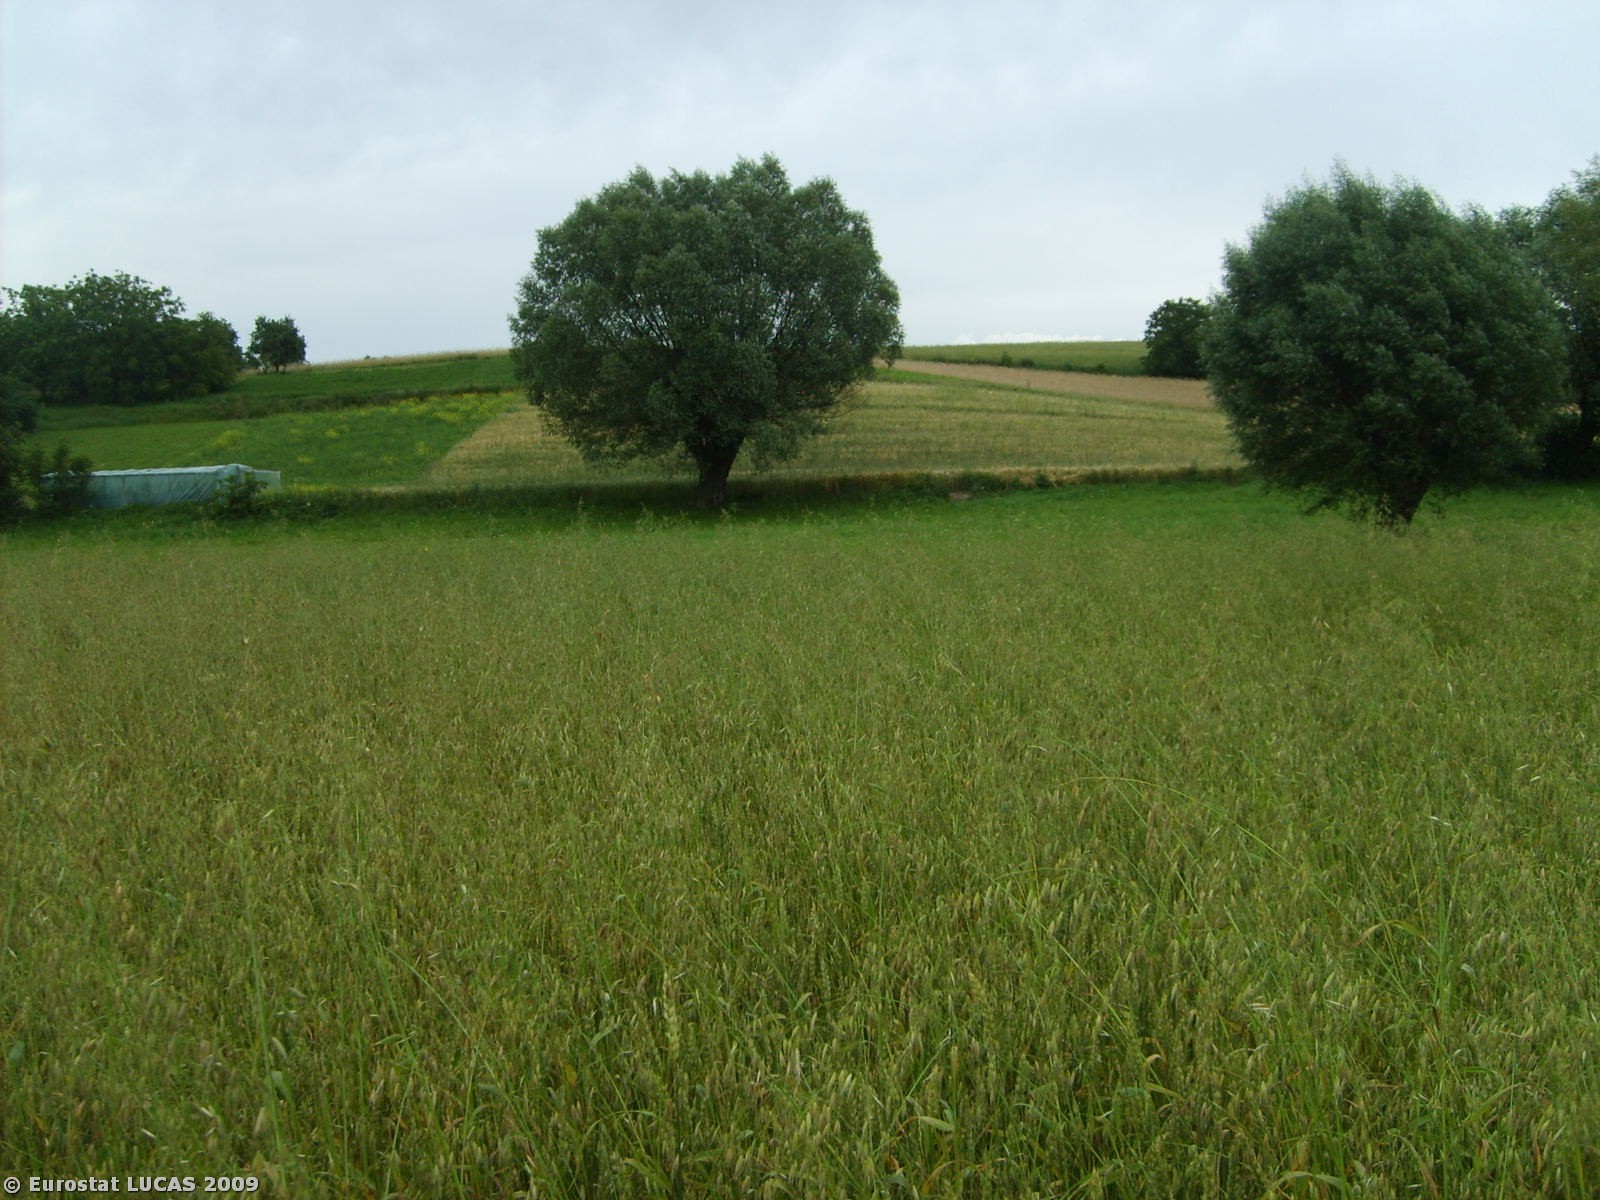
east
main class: Cropland
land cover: Mixed cereals for fodder
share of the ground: > 75 %
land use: Agriculture (excluding fallow land and kitchen gardens)
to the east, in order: Mixed cereals for fodder; Grass margins; Grassland with sparse tree/shrub cover; Grass margins; Mixed cereals for fodder; Grass margins; Clovers; Grass margins; Common wheat; Grass margins; Mixed cereals for fodder; Grass margins; Common wheat
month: July
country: PL
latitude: 50.3069
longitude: 20.5836
